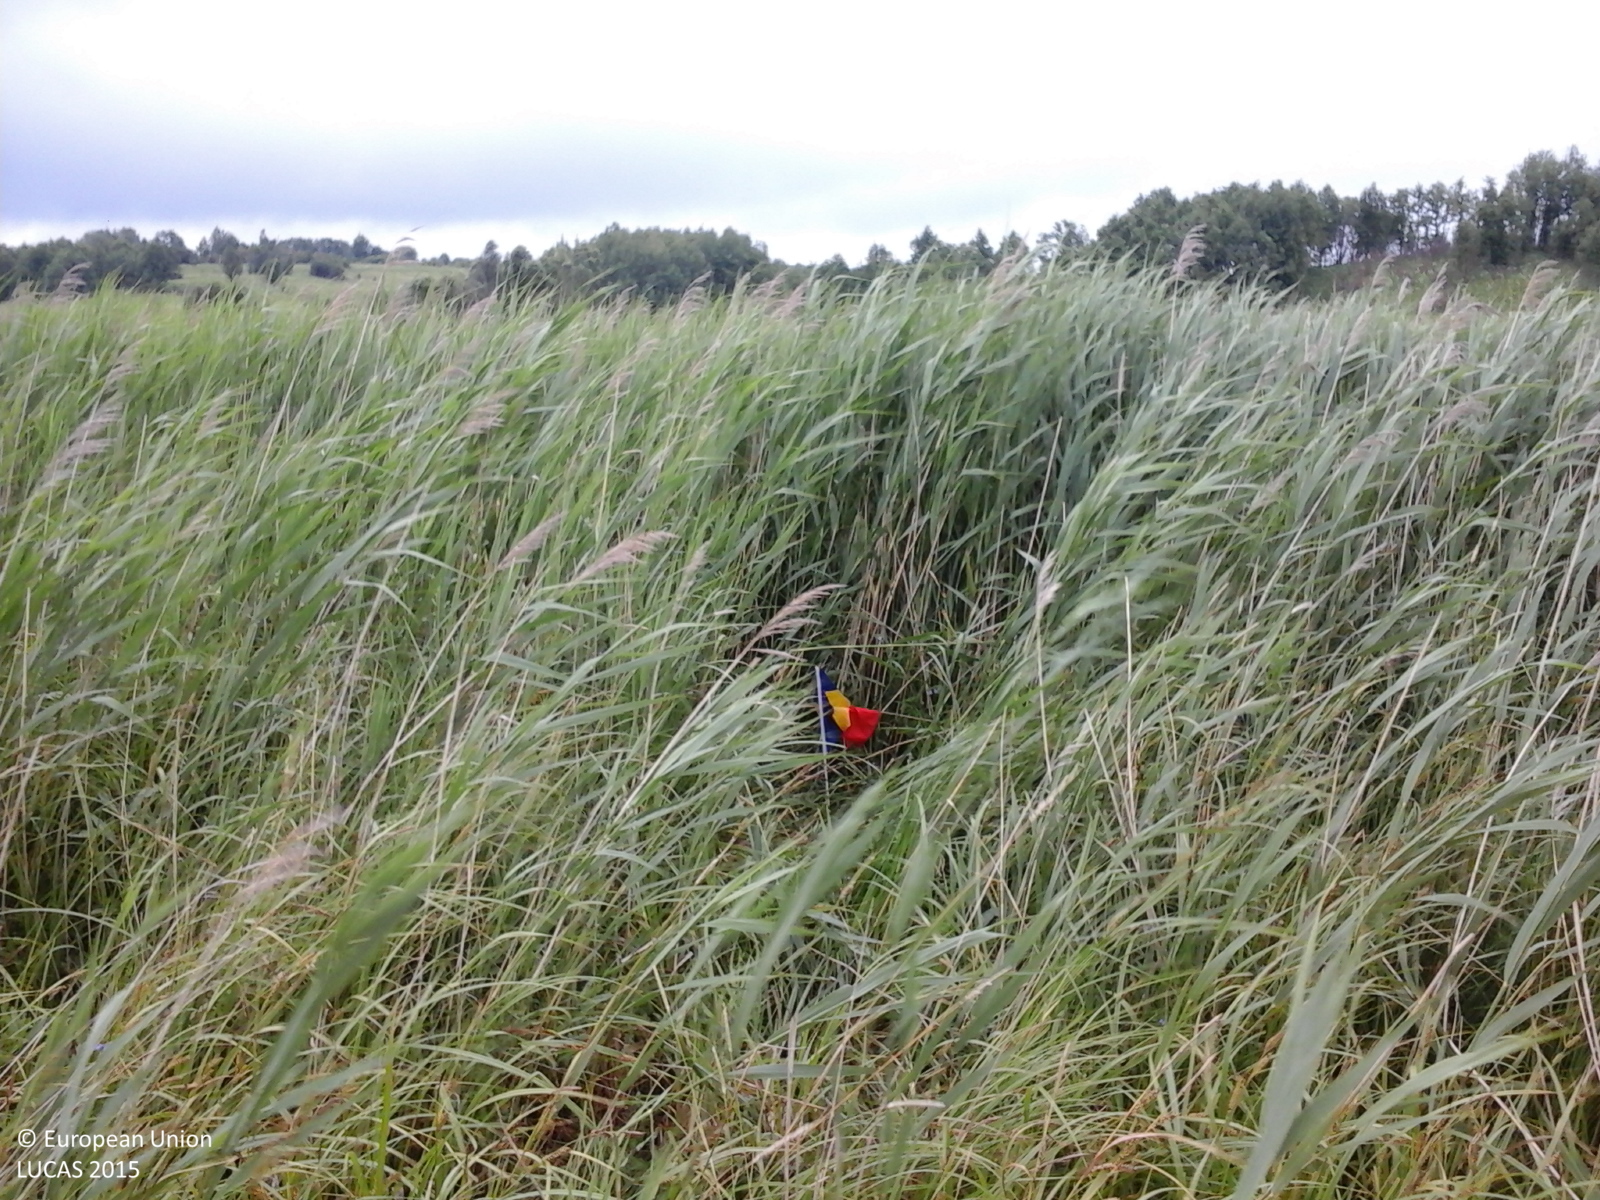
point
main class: Grassland
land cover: Spontaneously vegetated surfaces
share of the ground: > 75 %
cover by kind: herbaceous plants 100 %
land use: Fallow land
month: June
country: RO
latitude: 47.9634
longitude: 25.8654
